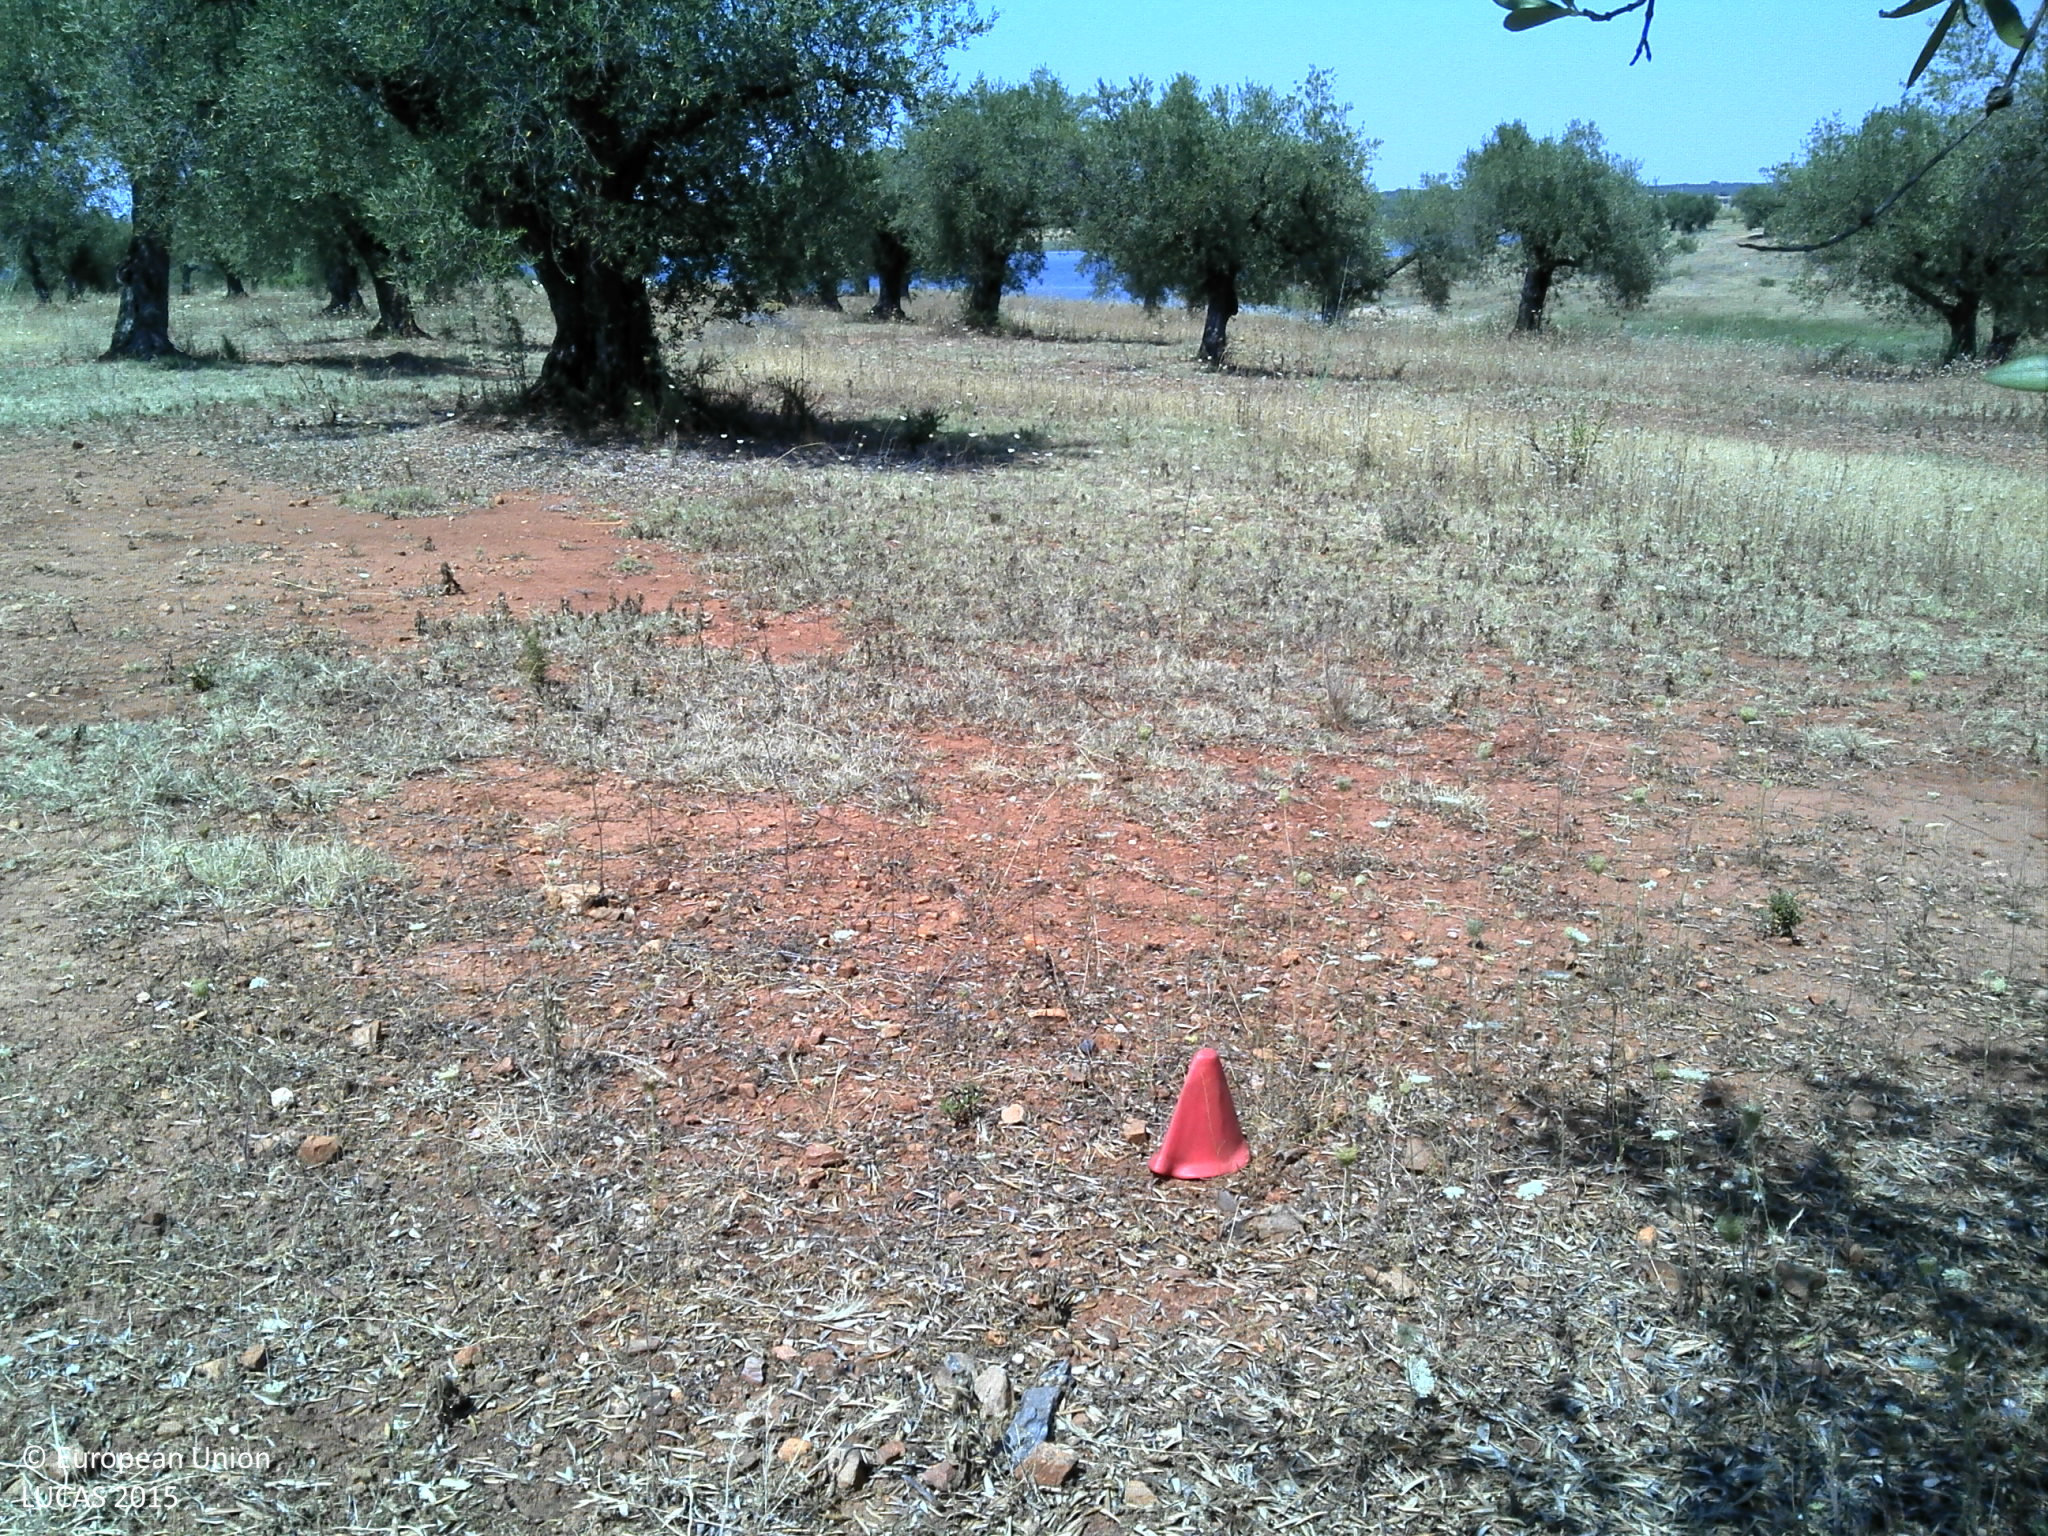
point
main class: Cropland
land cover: Olive groves
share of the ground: 25 - 50 %
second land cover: Grassland without tree/shrub cover
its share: 10 - 25 %
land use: Agriculture (excluding fallow land and kitchen gardens)
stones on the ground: < 10 %
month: June
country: PT
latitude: 38.0553
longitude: -7.5841
